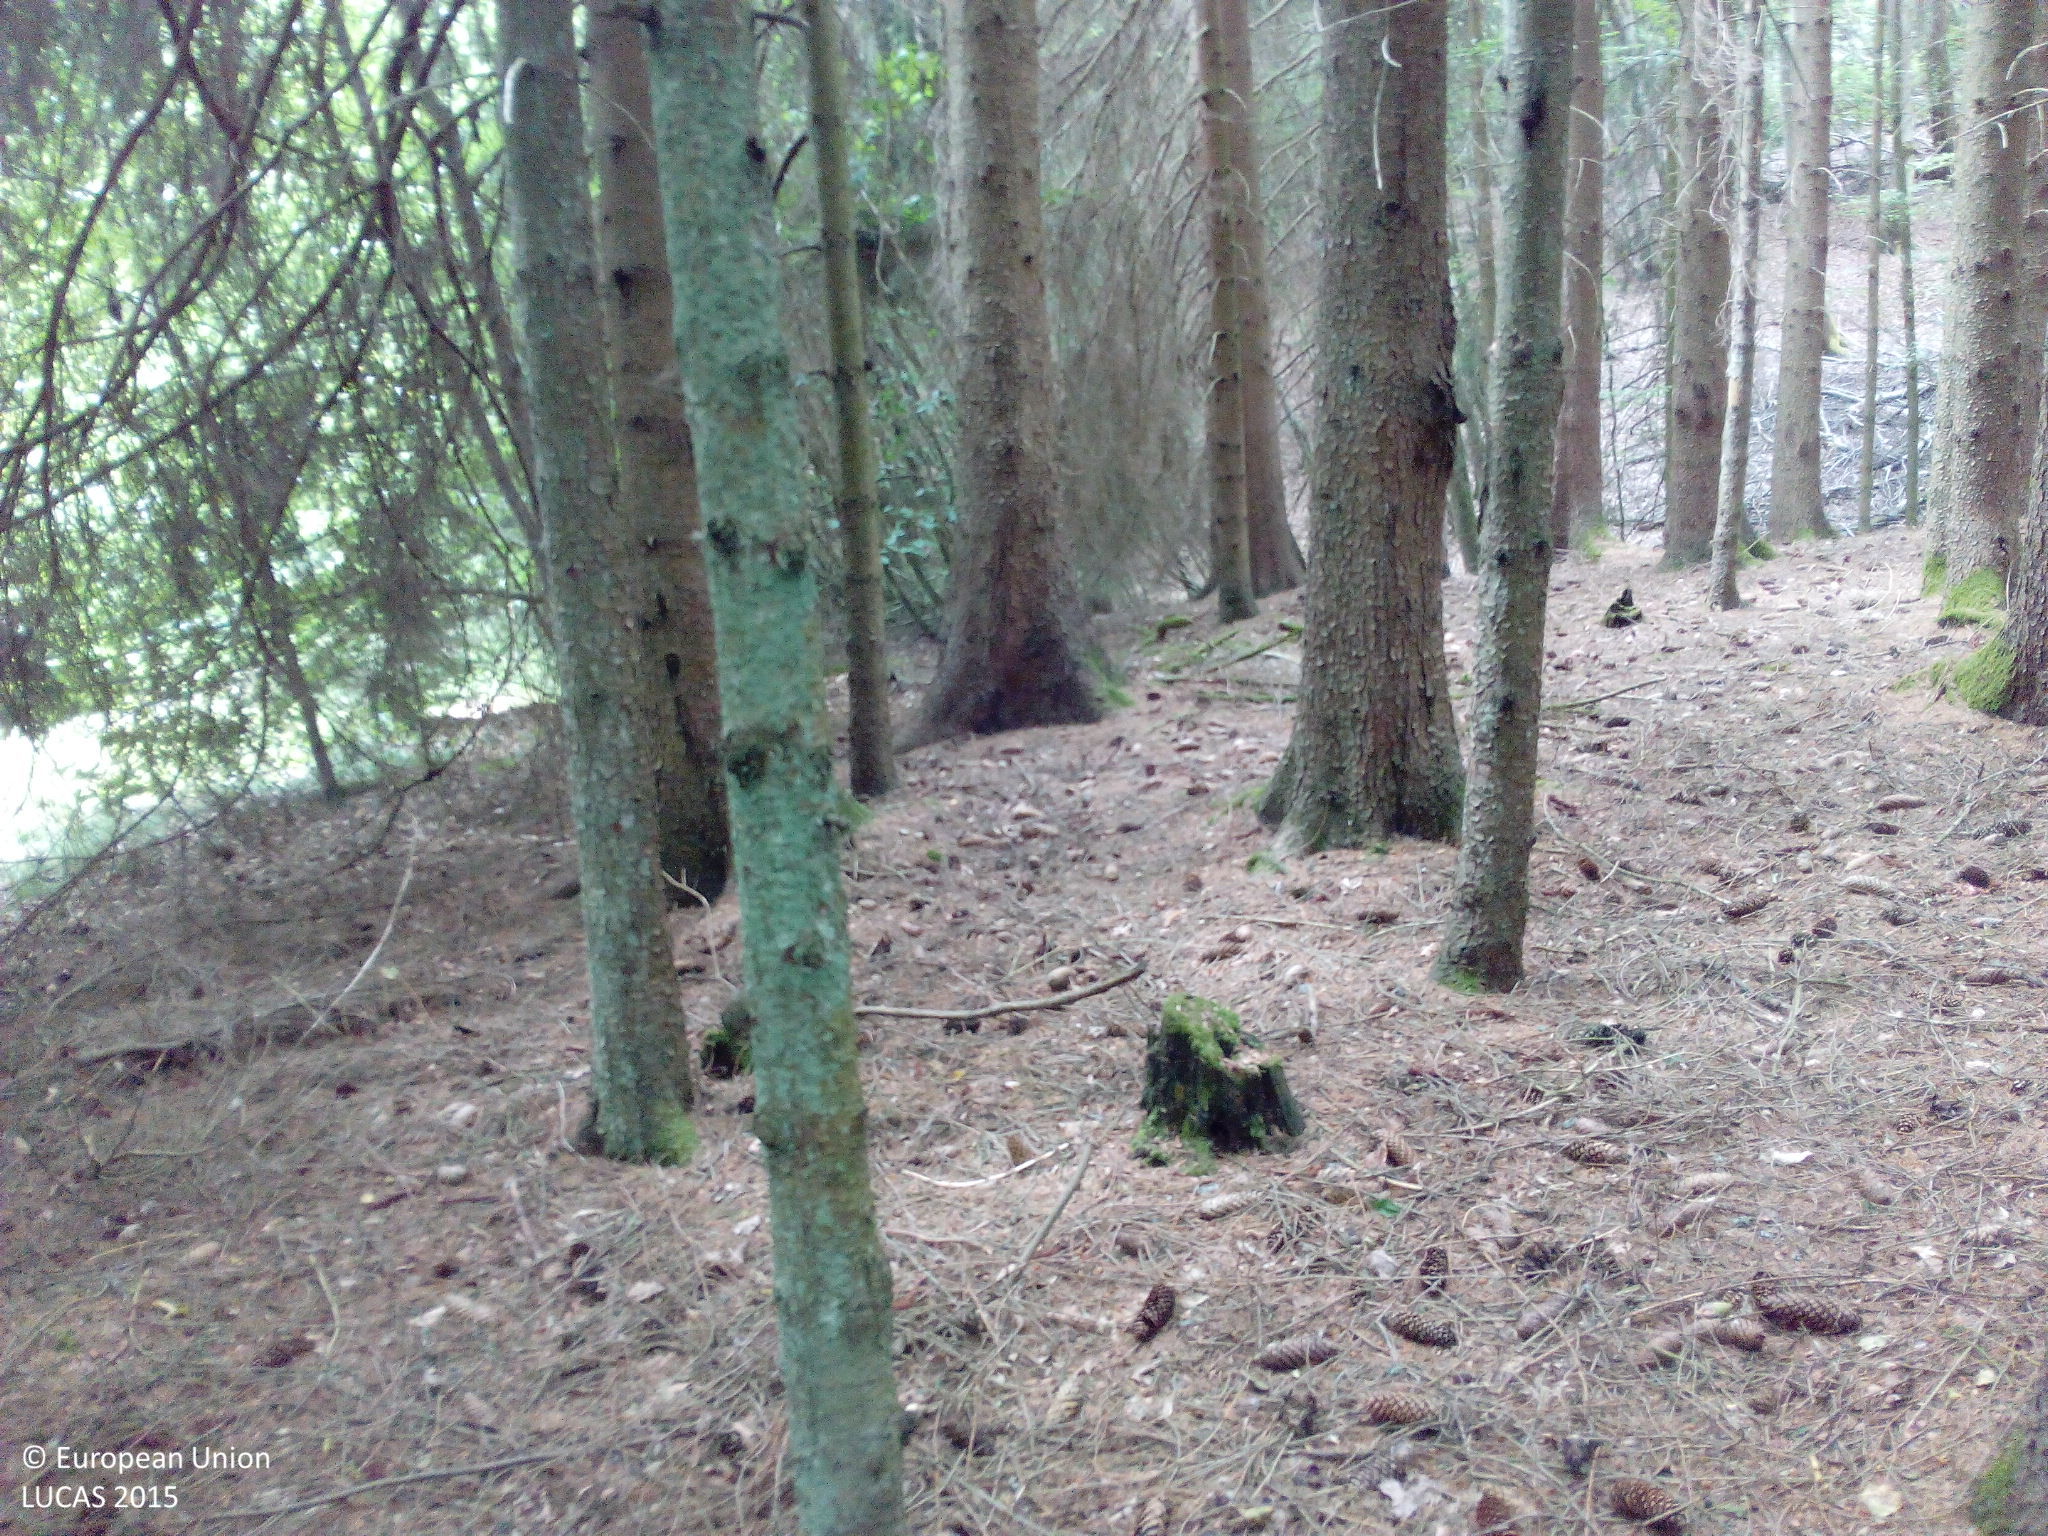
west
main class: Woodland
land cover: Spruce dominated coniferous woodland
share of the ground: > 75 %
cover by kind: coniferous forest trees 100 %
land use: Forestry
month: July
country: DE
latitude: 49.5891
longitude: 7.0814
